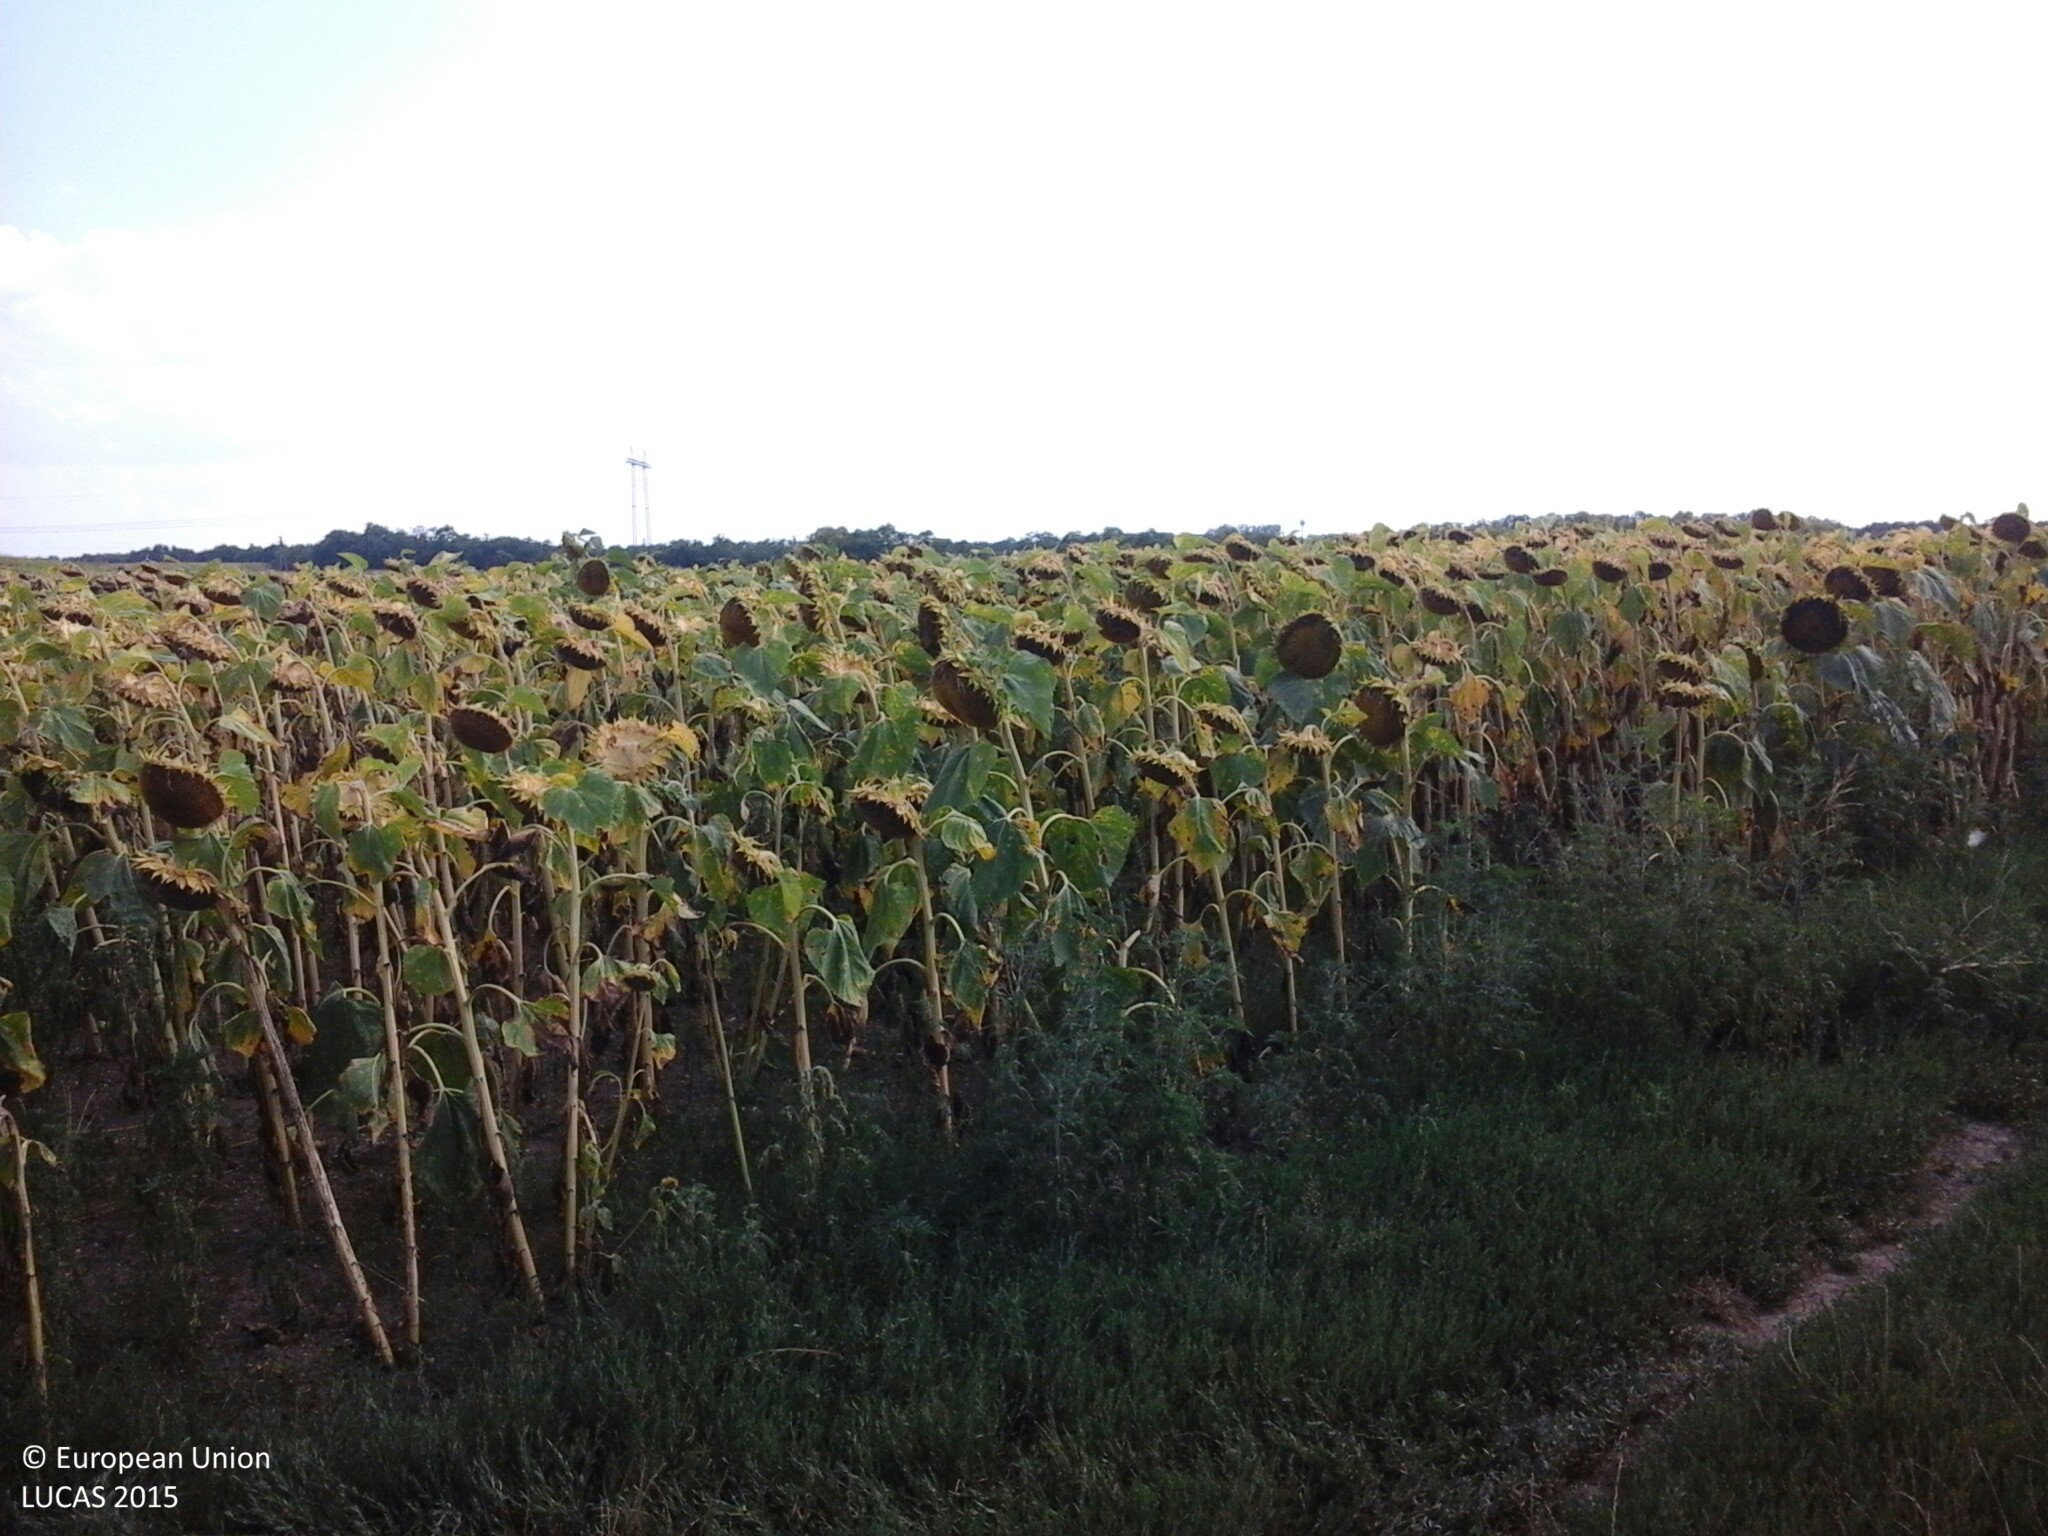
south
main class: Cropland
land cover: Sunflower
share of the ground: > 75 %
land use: Agriculture (excluding fallow land and kitchen gardens)
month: August
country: HU
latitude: 47.0903
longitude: 18.1381
